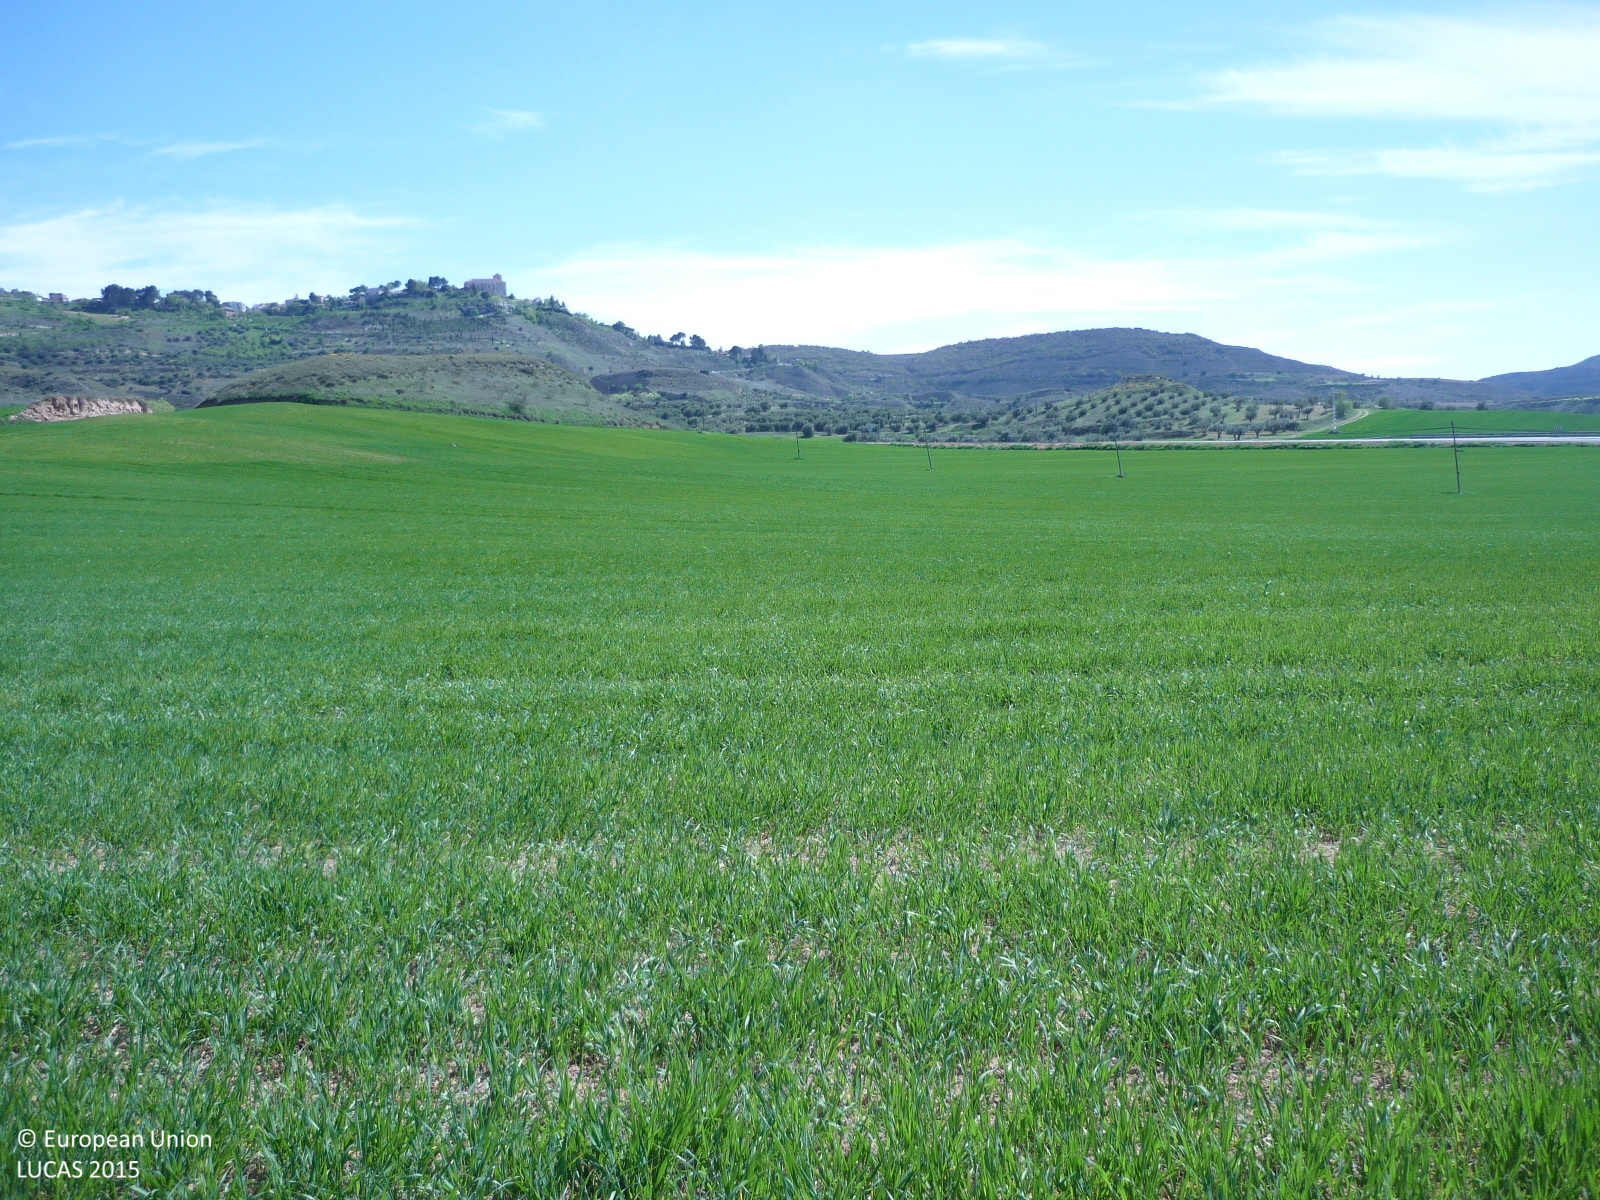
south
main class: Cropland
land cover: Barley
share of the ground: 50 - 75 %
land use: Agriculture (excluding fallow land and kitchen gardens)
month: April
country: ES
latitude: 40.5156
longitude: -3.2638
